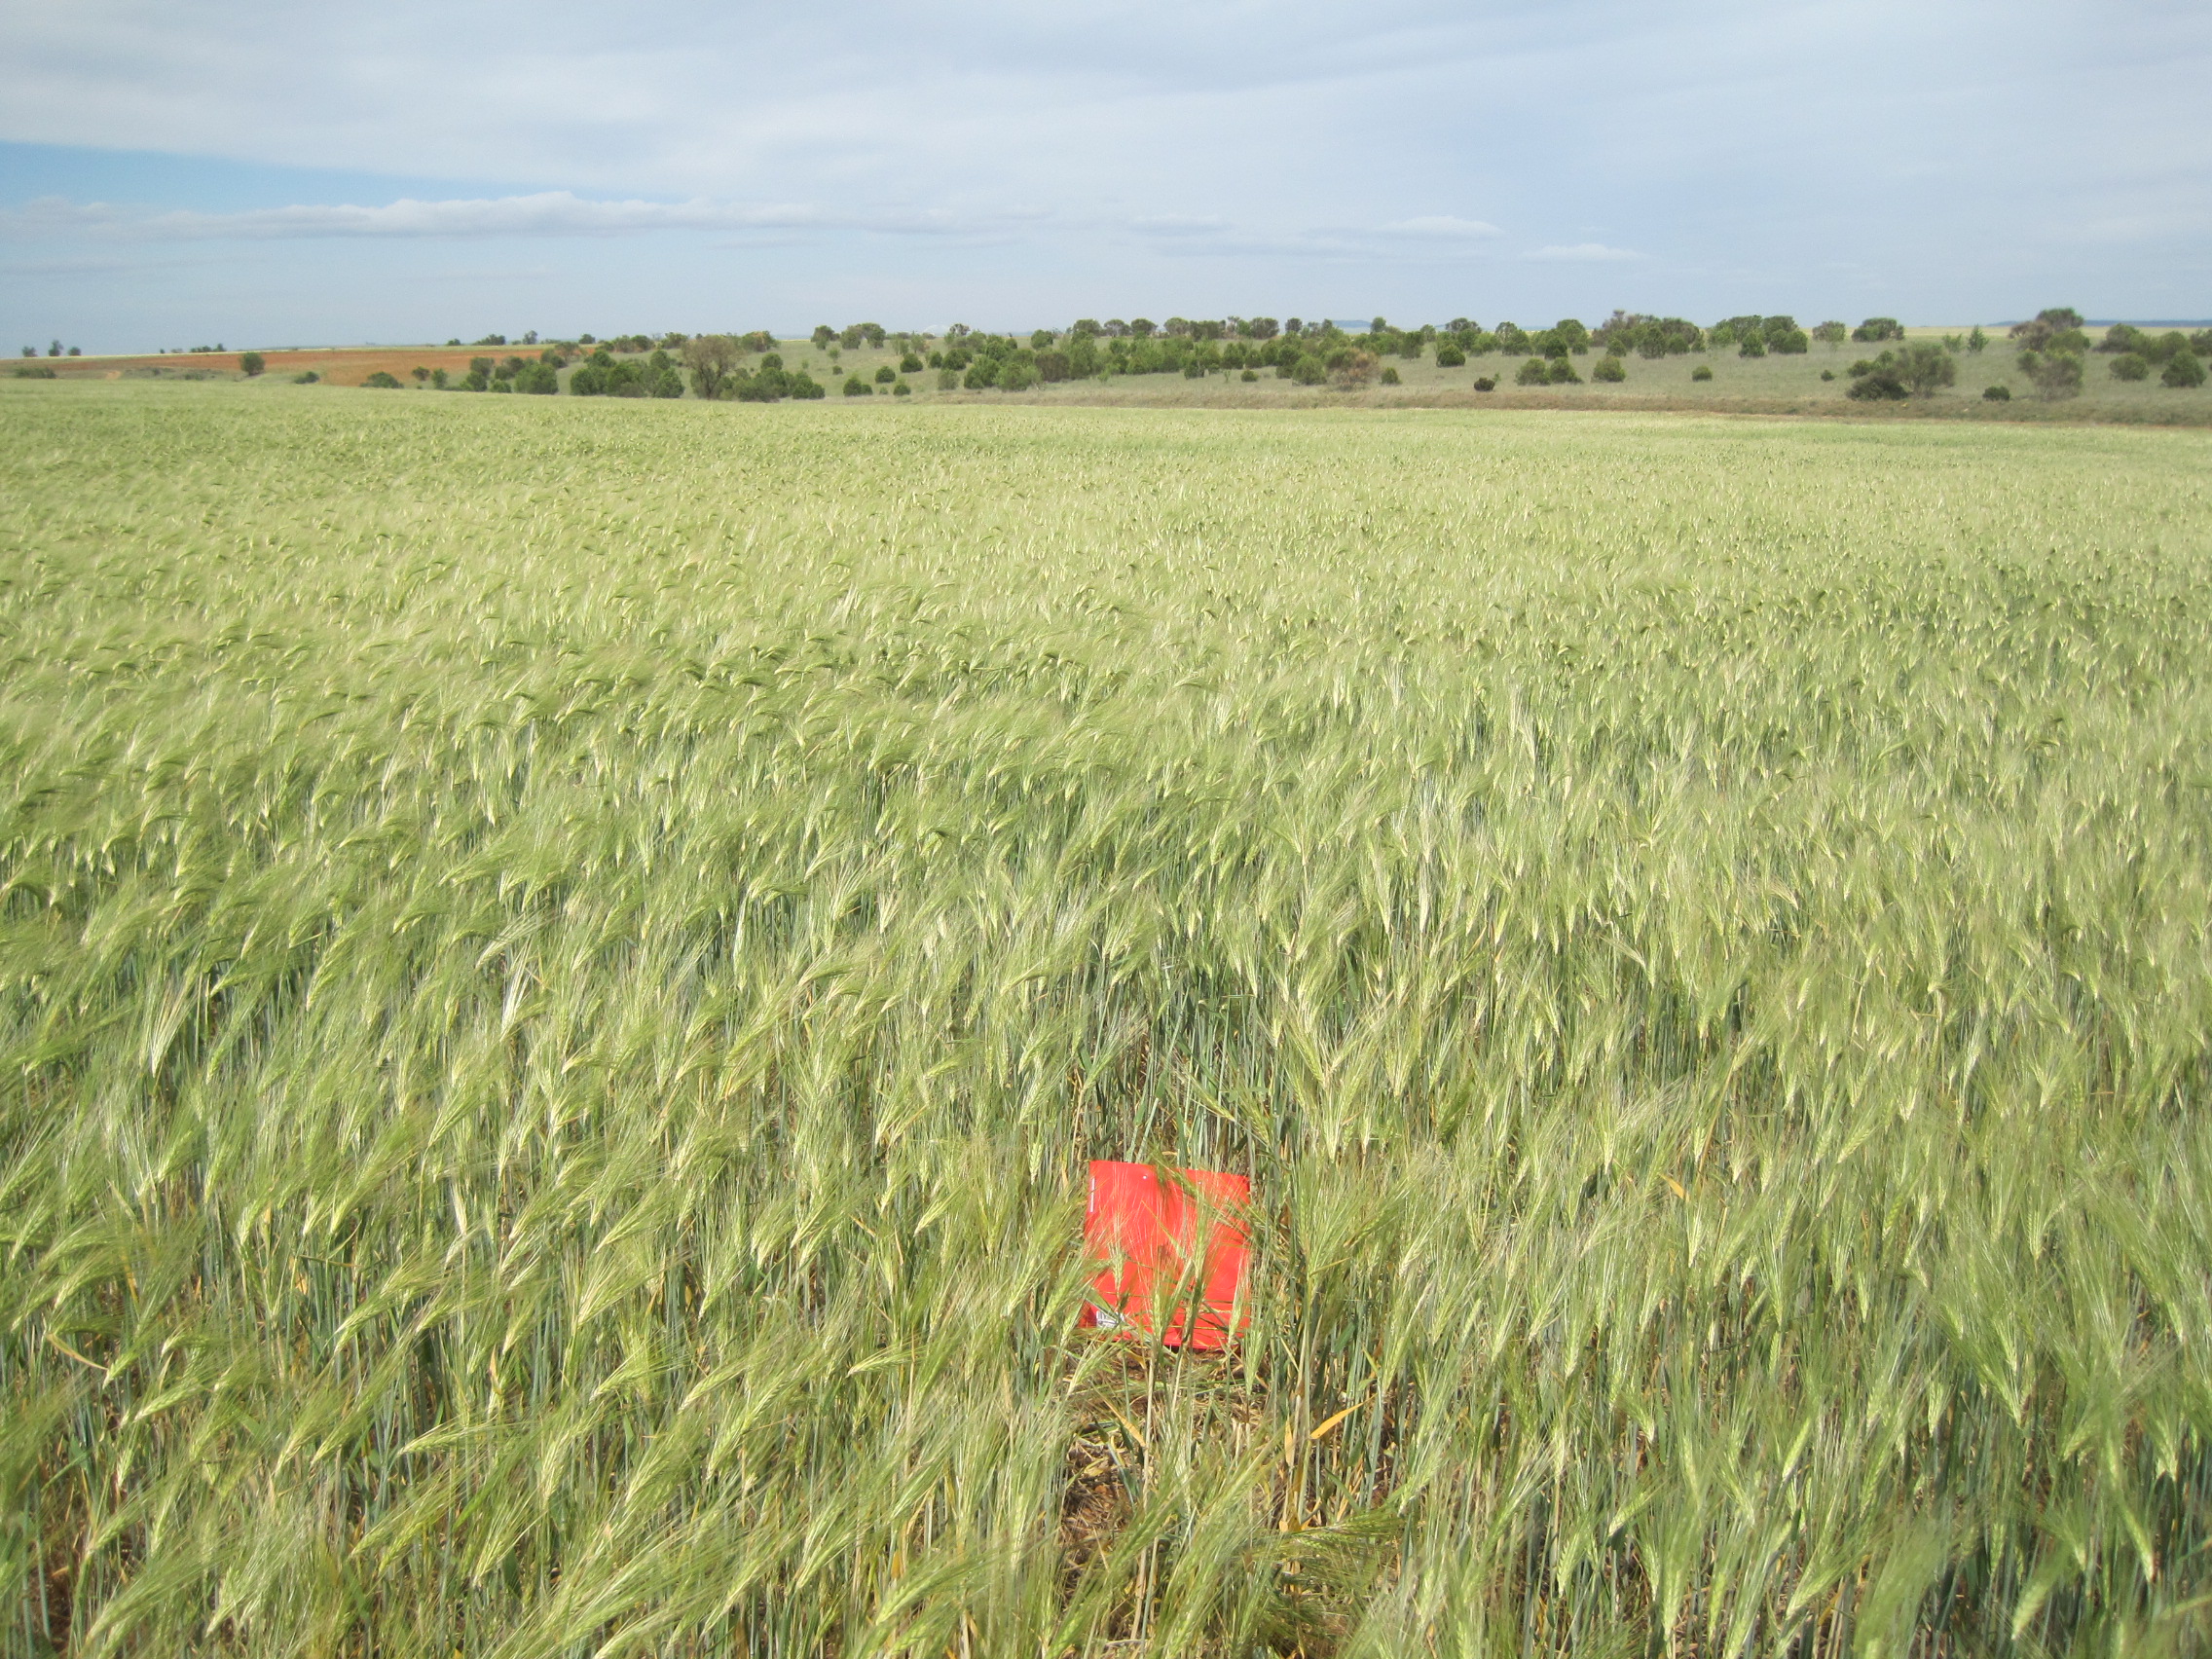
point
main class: Cropland
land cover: Barley
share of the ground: > 75 %
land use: Agriculture (excluding fallow land and kitchen gardens)
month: May
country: ES
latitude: 41.7133
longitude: -5.3577
